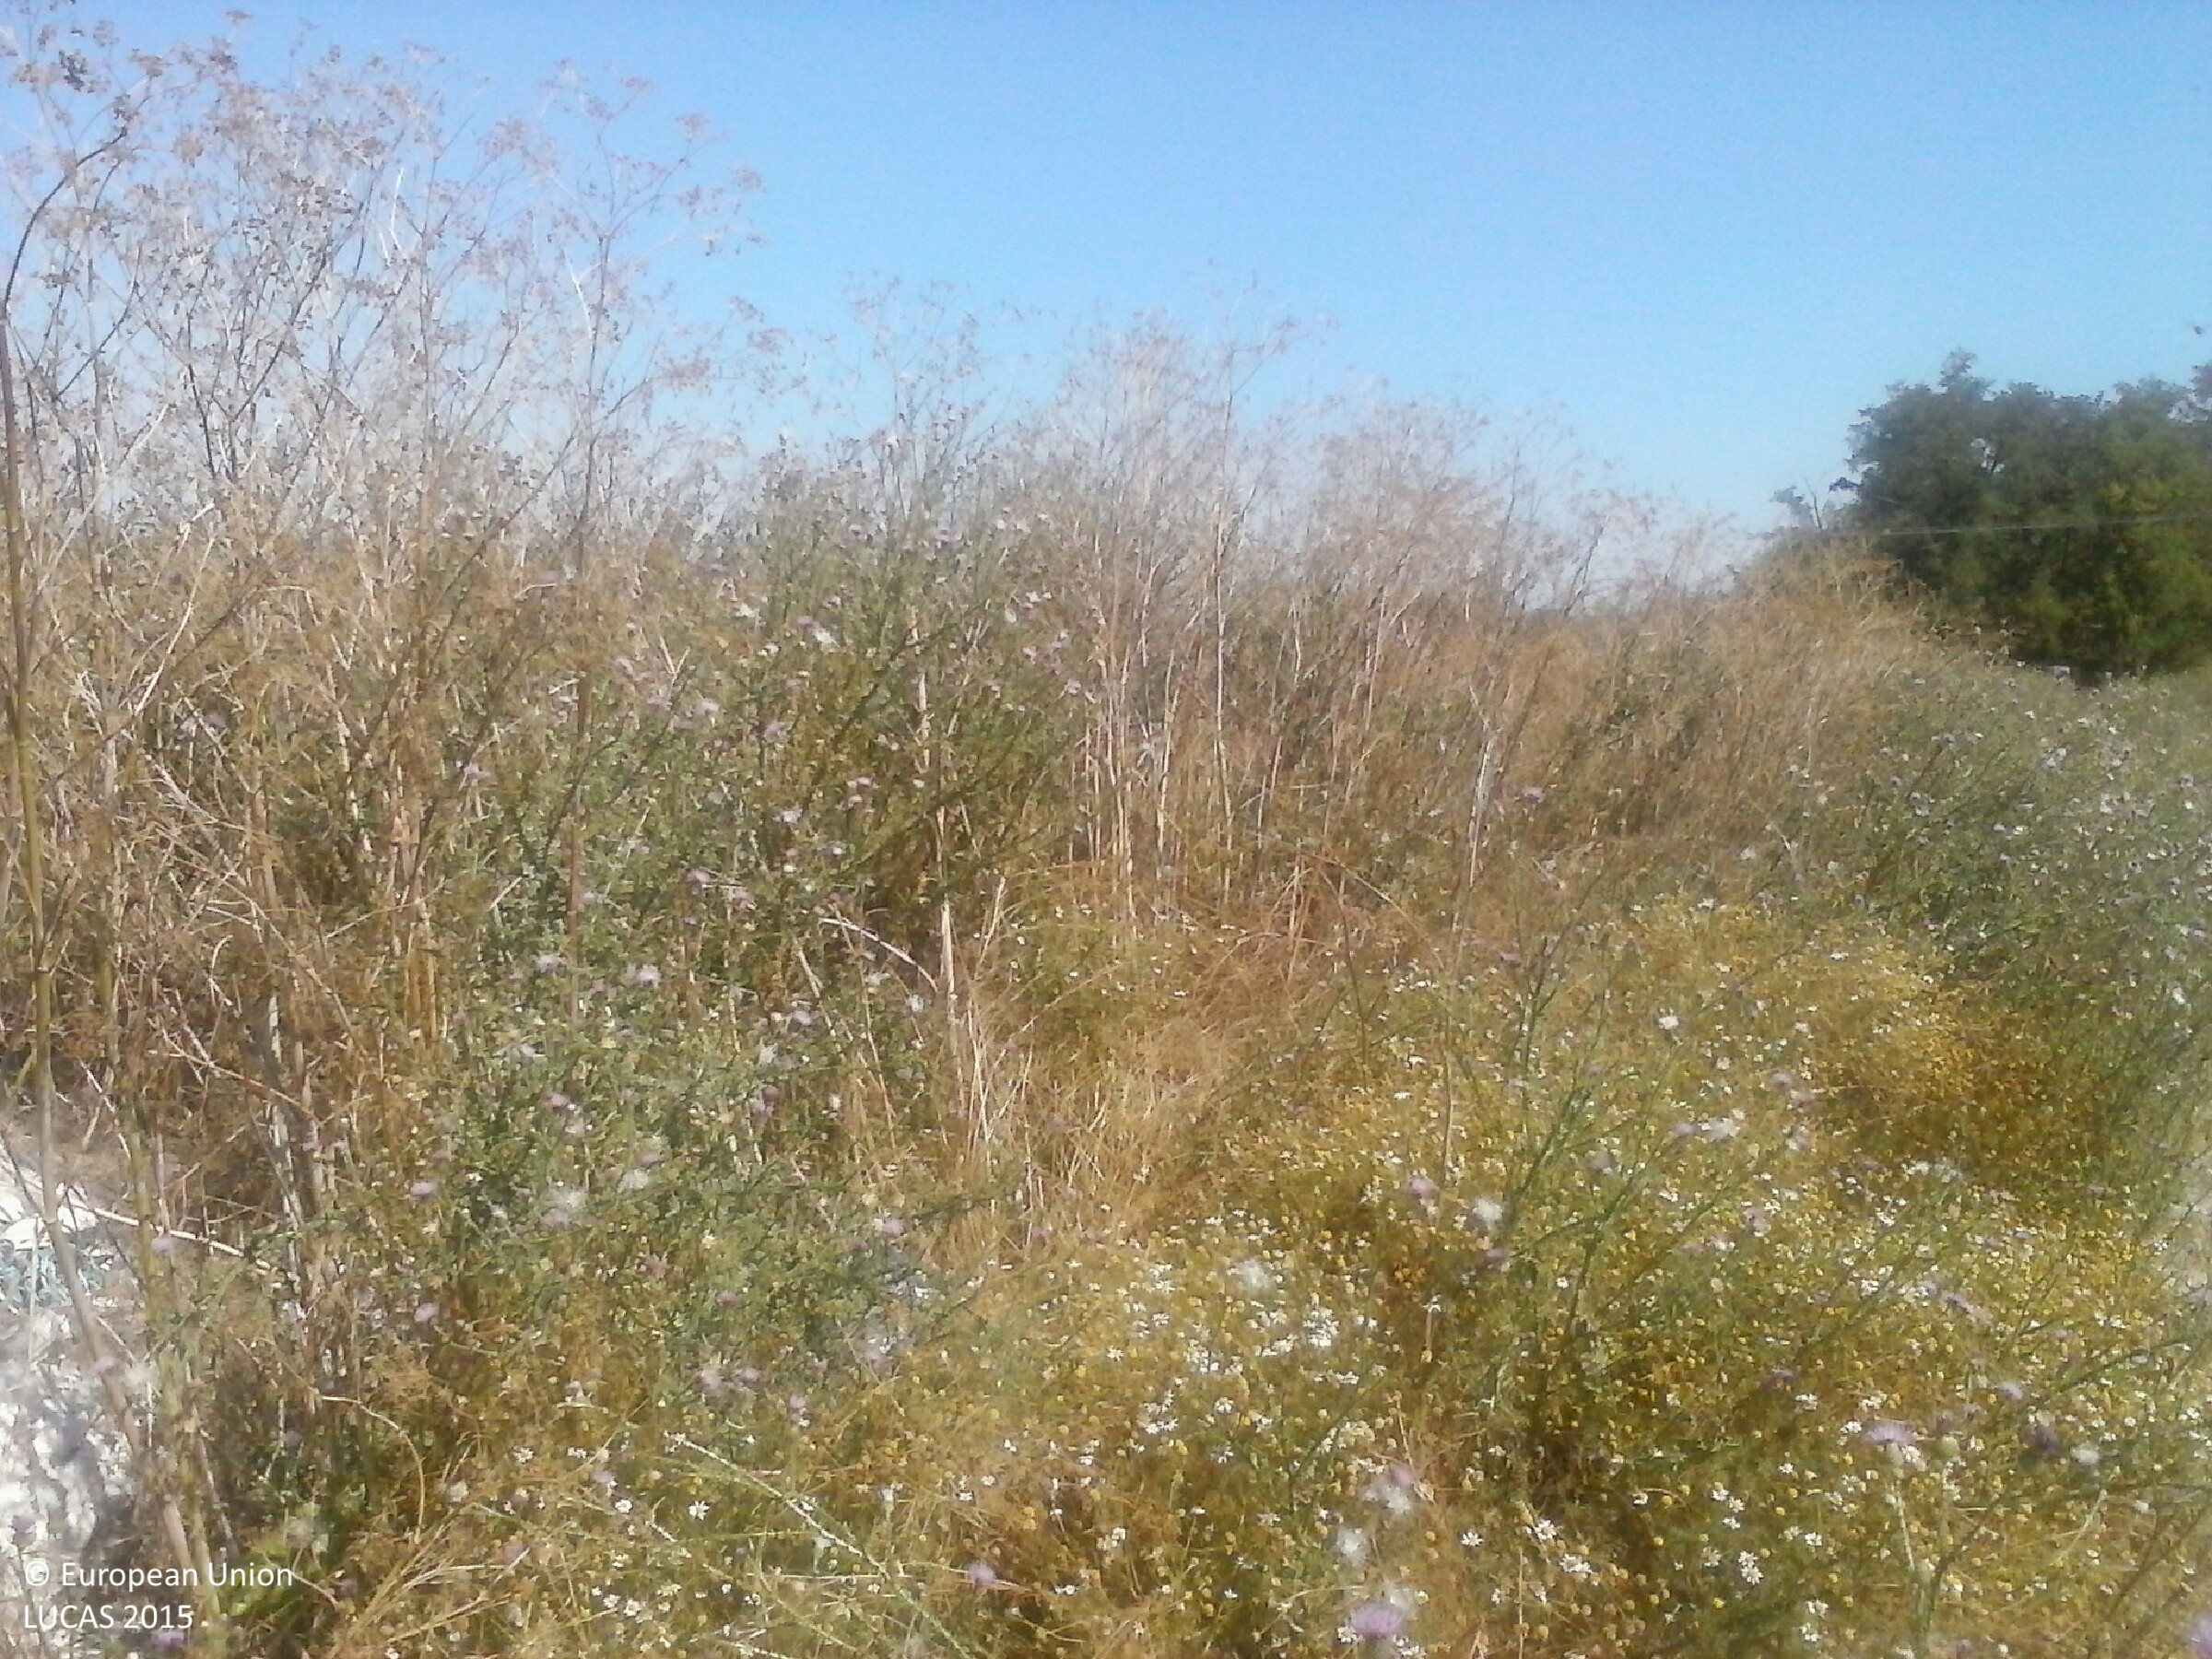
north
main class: Grassland
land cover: Spontaneously vegetated surfaces
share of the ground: 50 - 75 %
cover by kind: herbaceous plants 70 %, unconsolidated bare surface 30 %
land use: Abandoned areas
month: July
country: HU
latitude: 46.6226
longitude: 20.4086
